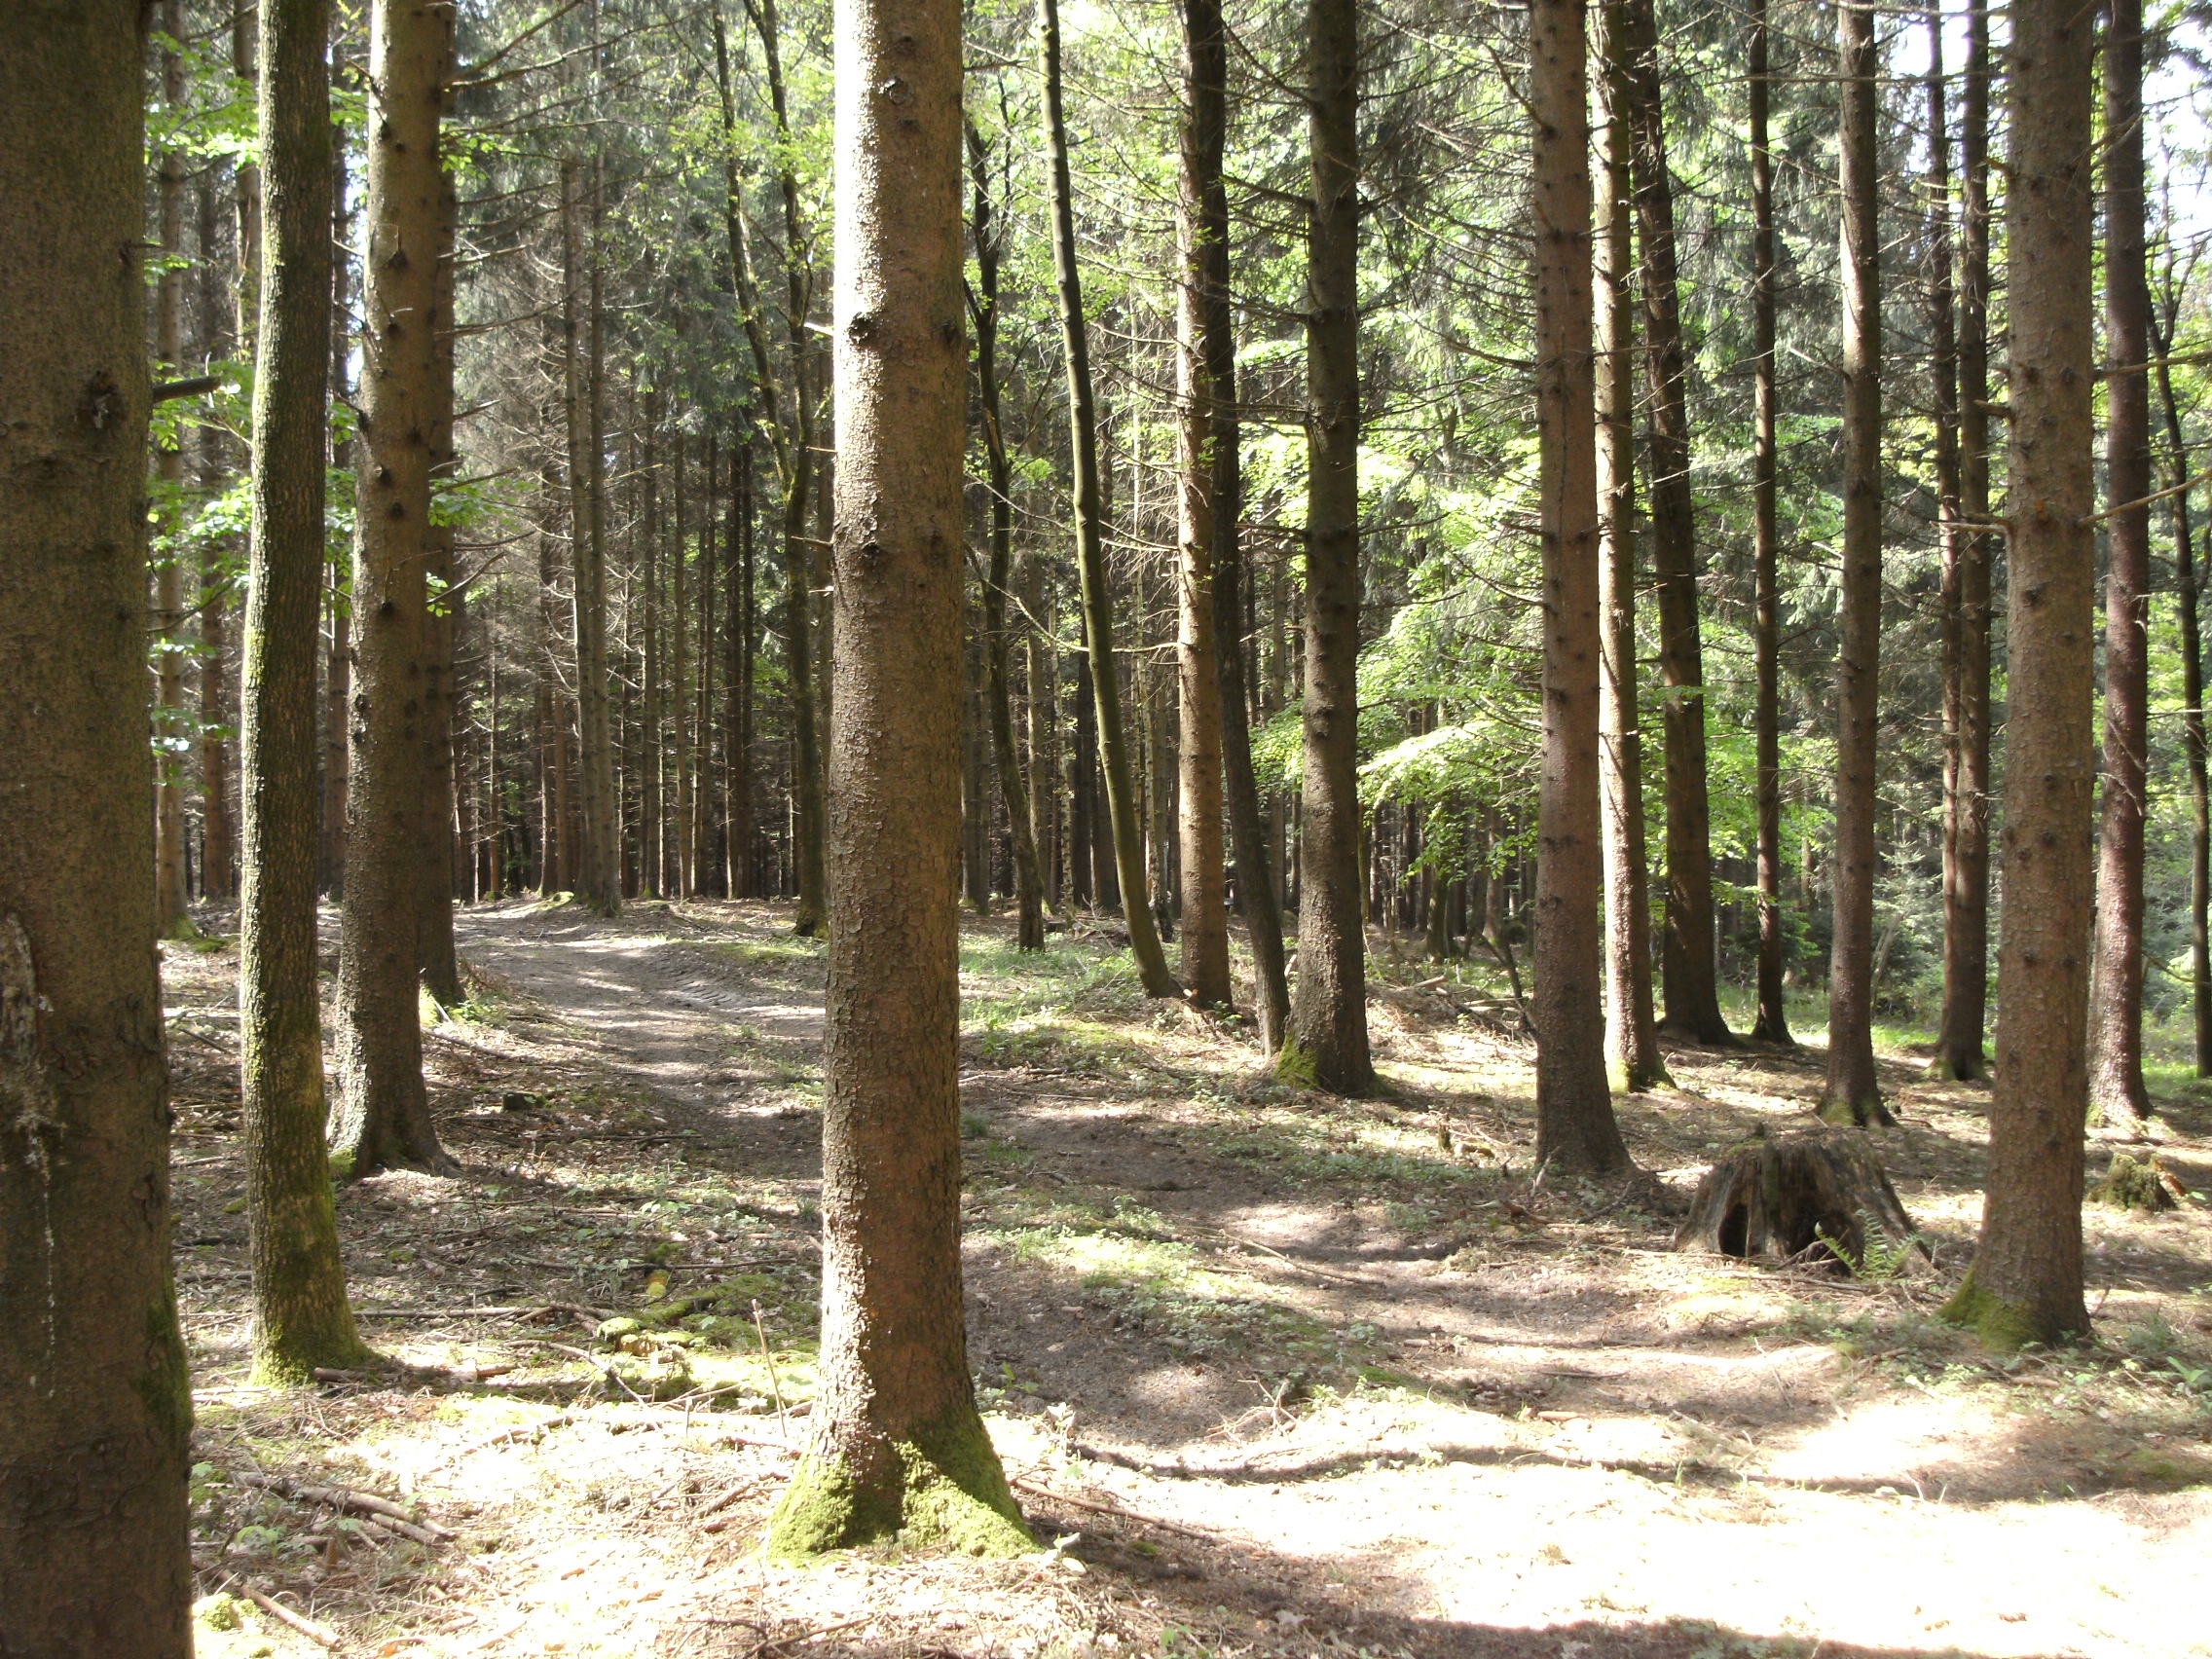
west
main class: Woodland
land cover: Spruce dominated coniferous woodland
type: hemiboreal forest and nemoral coniferous forest and mixed broadleaved-coniferous forest
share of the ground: > 75 %
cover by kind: coniferous forest trees 100 %
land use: Forestry
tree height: > 5 m
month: May
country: AT
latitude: 48.5297
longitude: 13.4527
